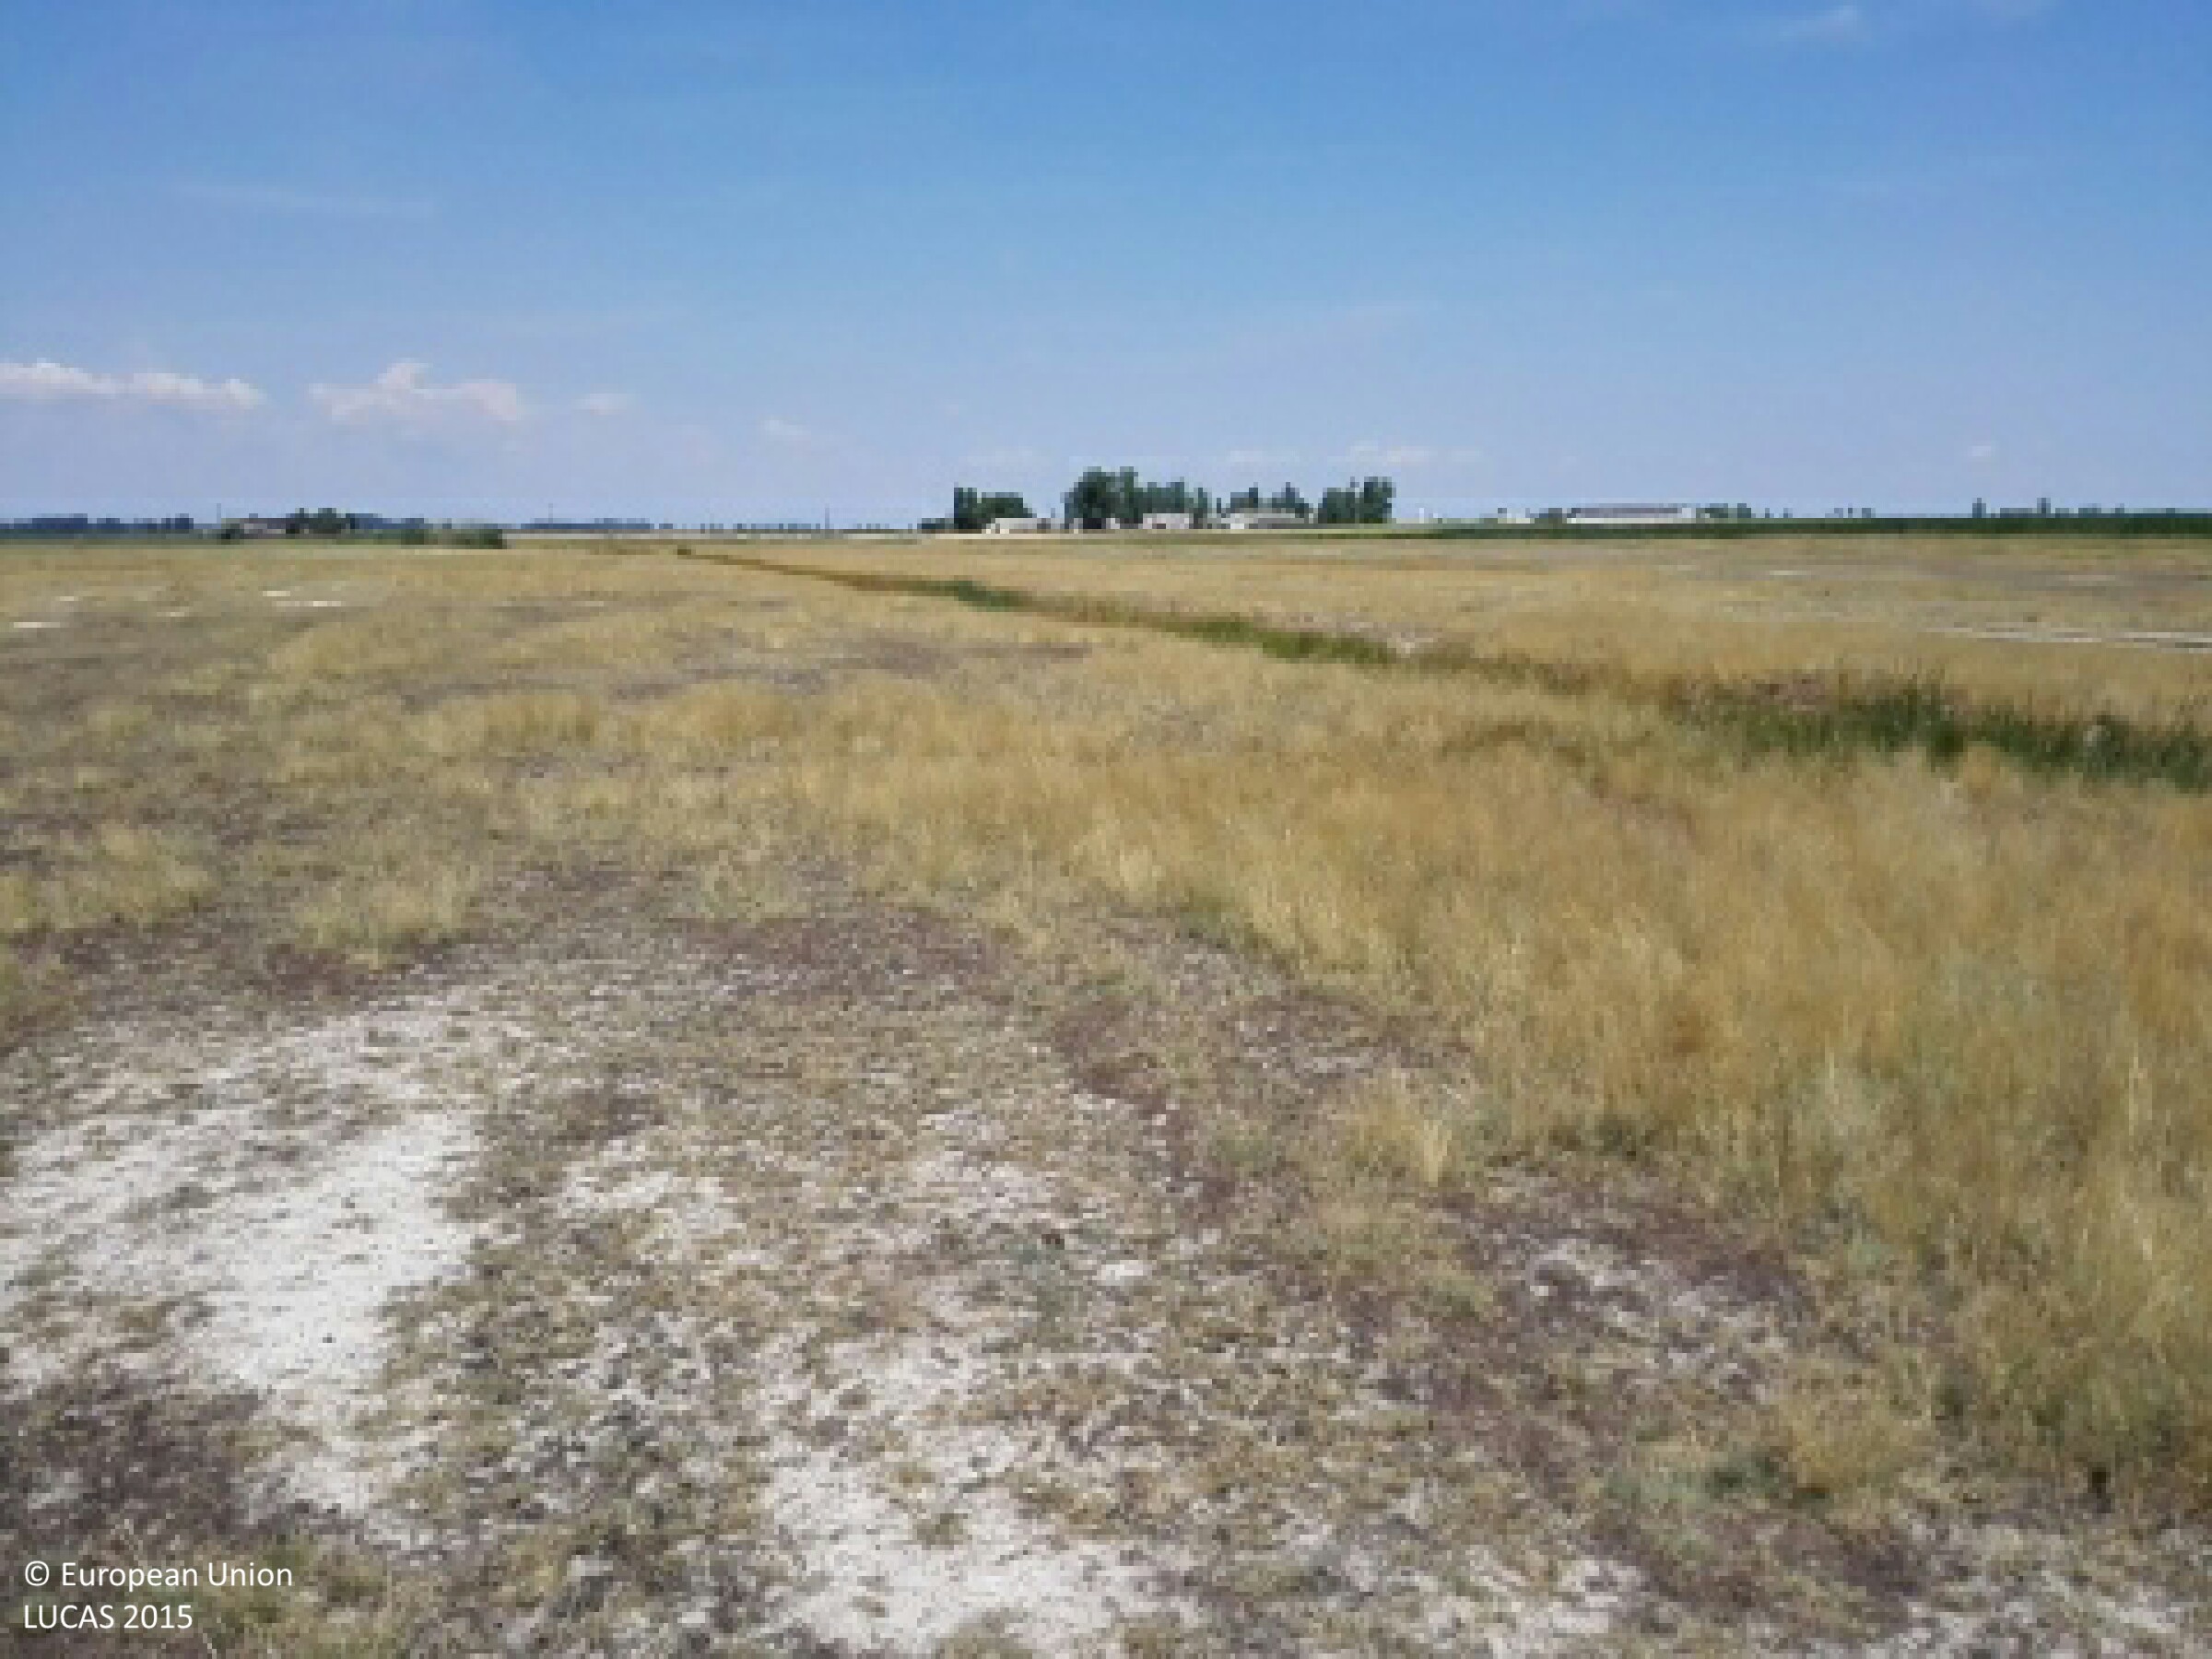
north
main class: Grassland
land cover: Grassland without tree/shrub cover
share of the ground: 25 - 50 %
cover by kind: herbaceous plants 95 %, consolidated bare surface 5 %
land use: Agriculture (excluding fallow land and kitchen gardens)
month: July
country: HU
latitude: 47.7045
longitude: 21.3835
